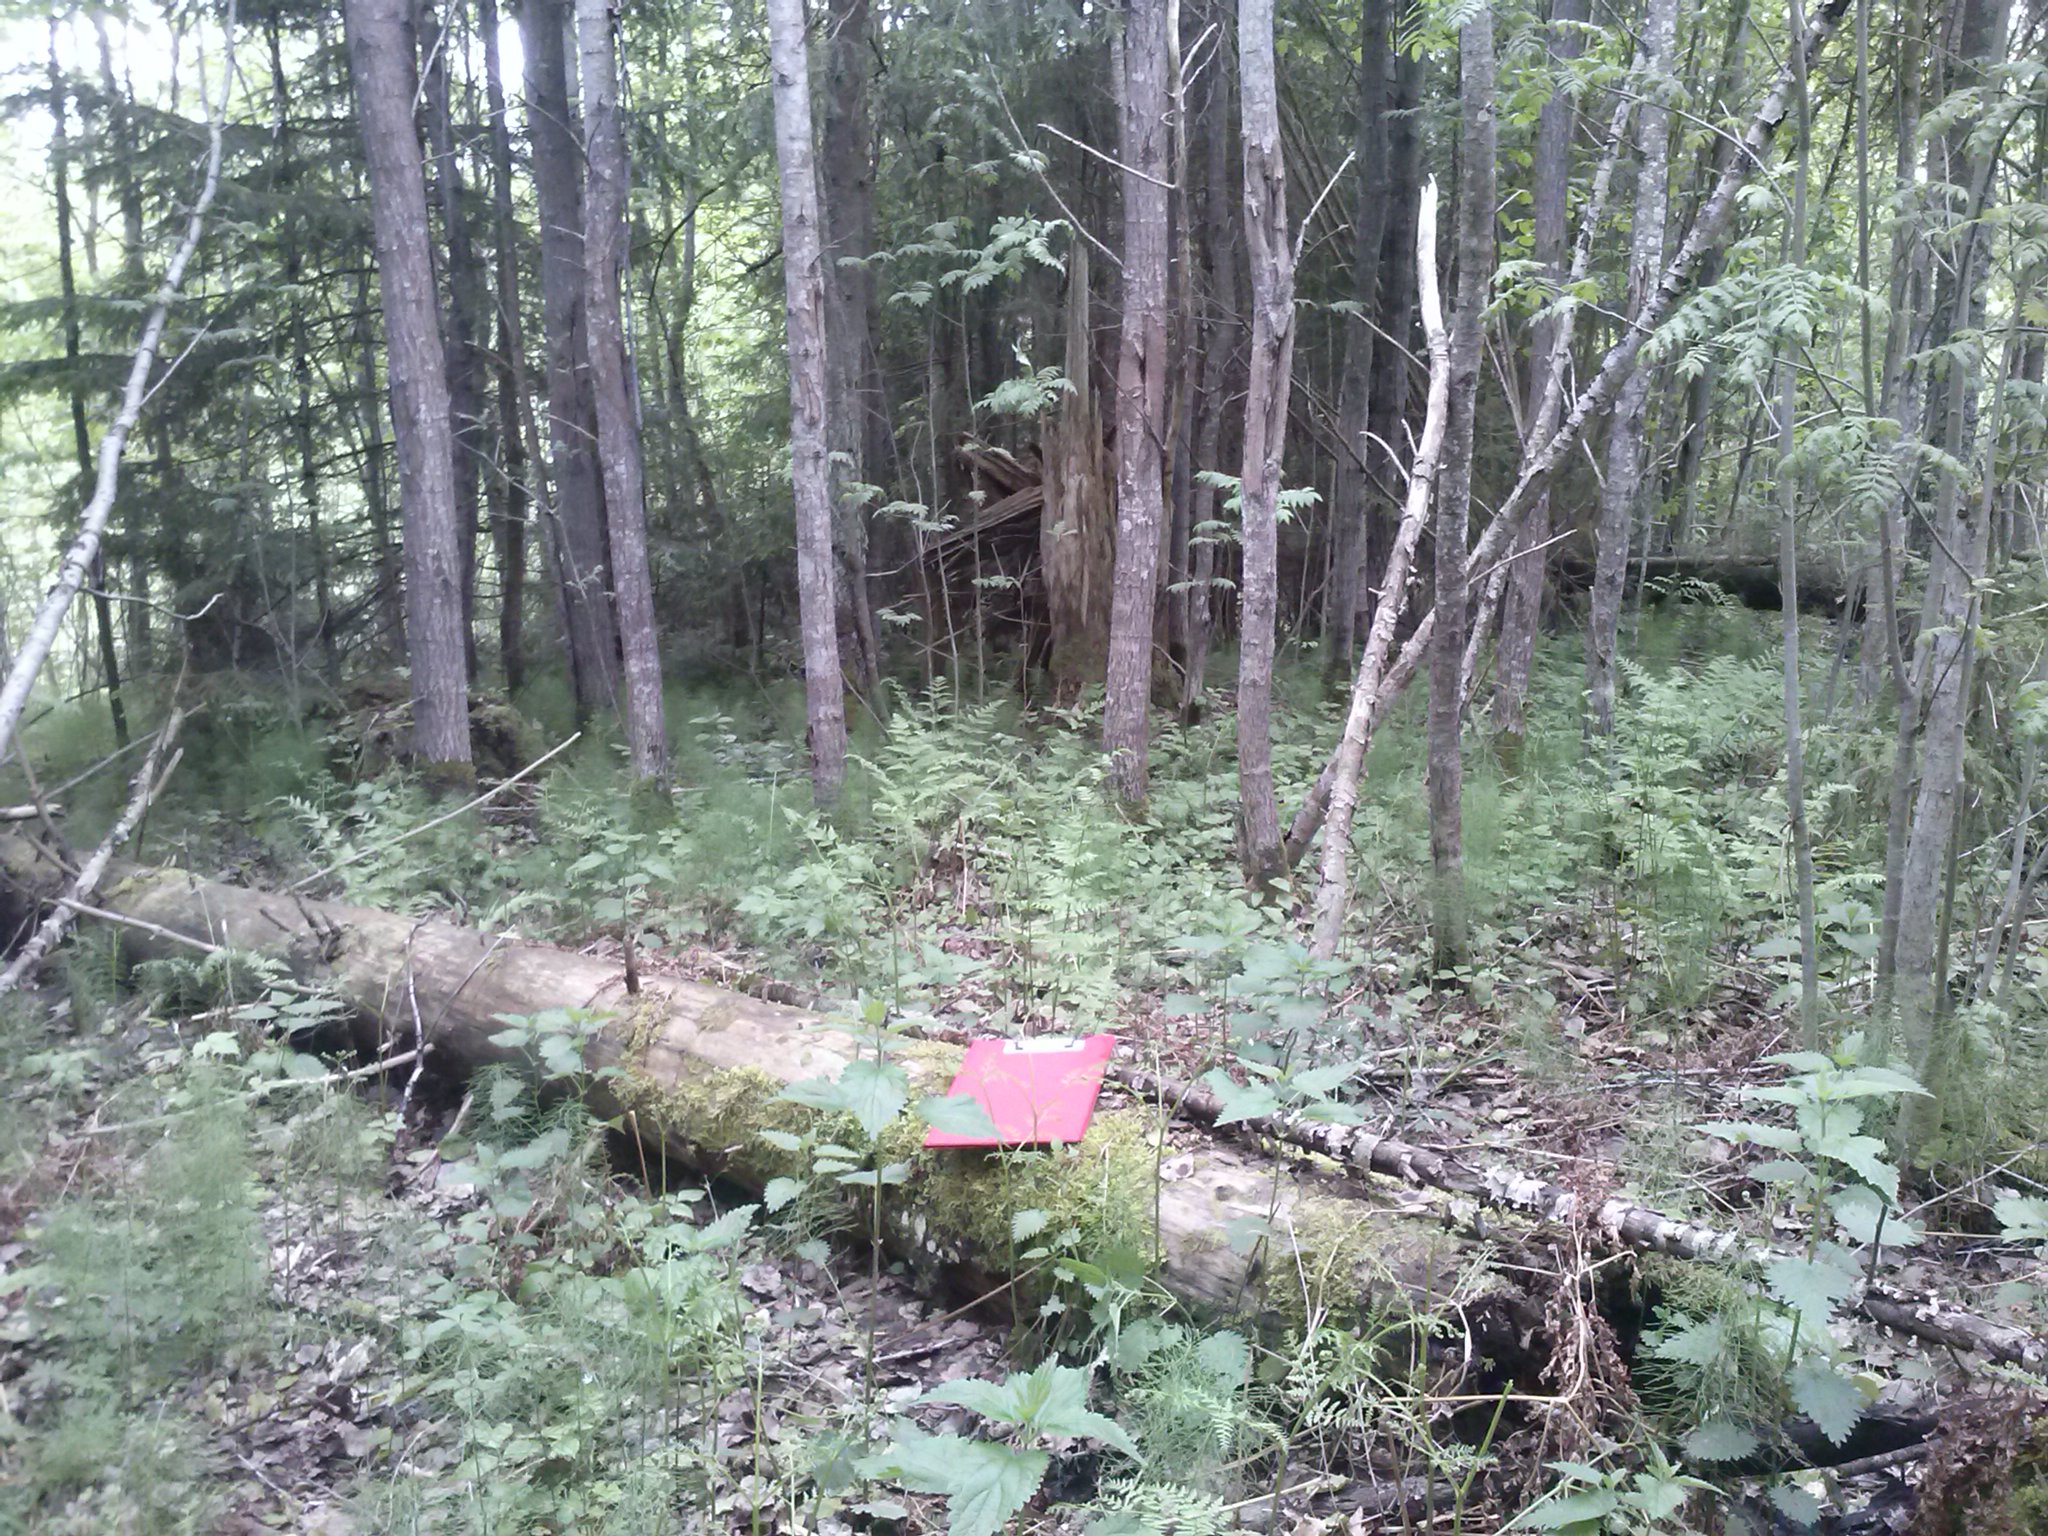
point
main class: Woodland
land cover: Broadleaved woodland
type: non-riverine alder, birch or aspen forest
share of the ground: > 75 %
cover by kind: broadleaved forest trees 80 %, coniferous forest trees 10 %, herbaceous plants 10 %
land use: Forestry
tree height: > 5 m
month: May
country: LV
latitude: 56.2270
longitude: 27.7542
